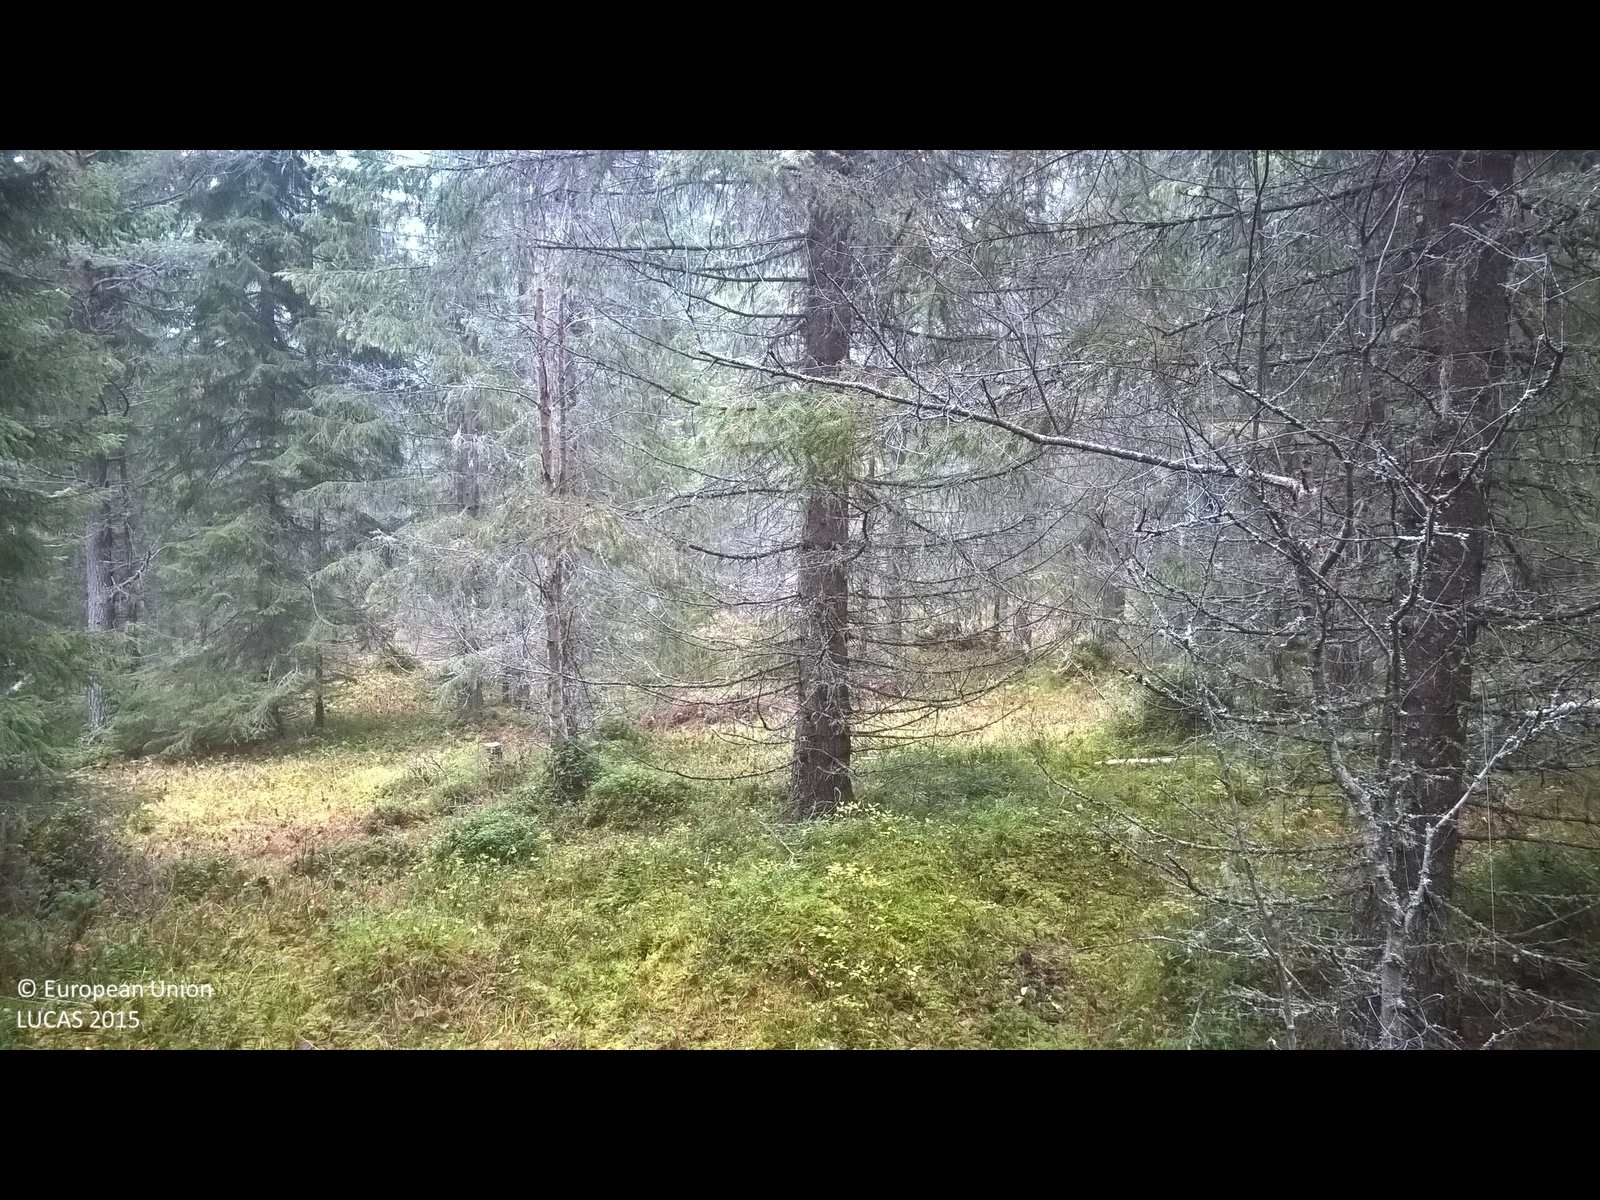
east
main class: Woodland
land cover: Spruce dominated coniferous woodland
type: boreal forest
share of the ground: > 75 %
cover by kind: coniferous forest trees 85 %, lichens and mosses 15 %
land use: Forestry
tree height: > 5 m
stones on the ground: < 10 %
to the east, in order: Spruce dominated coniferous woodland; Fences; Grassland with sparse tree/shrub cover; Shrubland with sparse tree cover
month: October
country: SE
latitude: 62.9461
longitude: 14.9648
